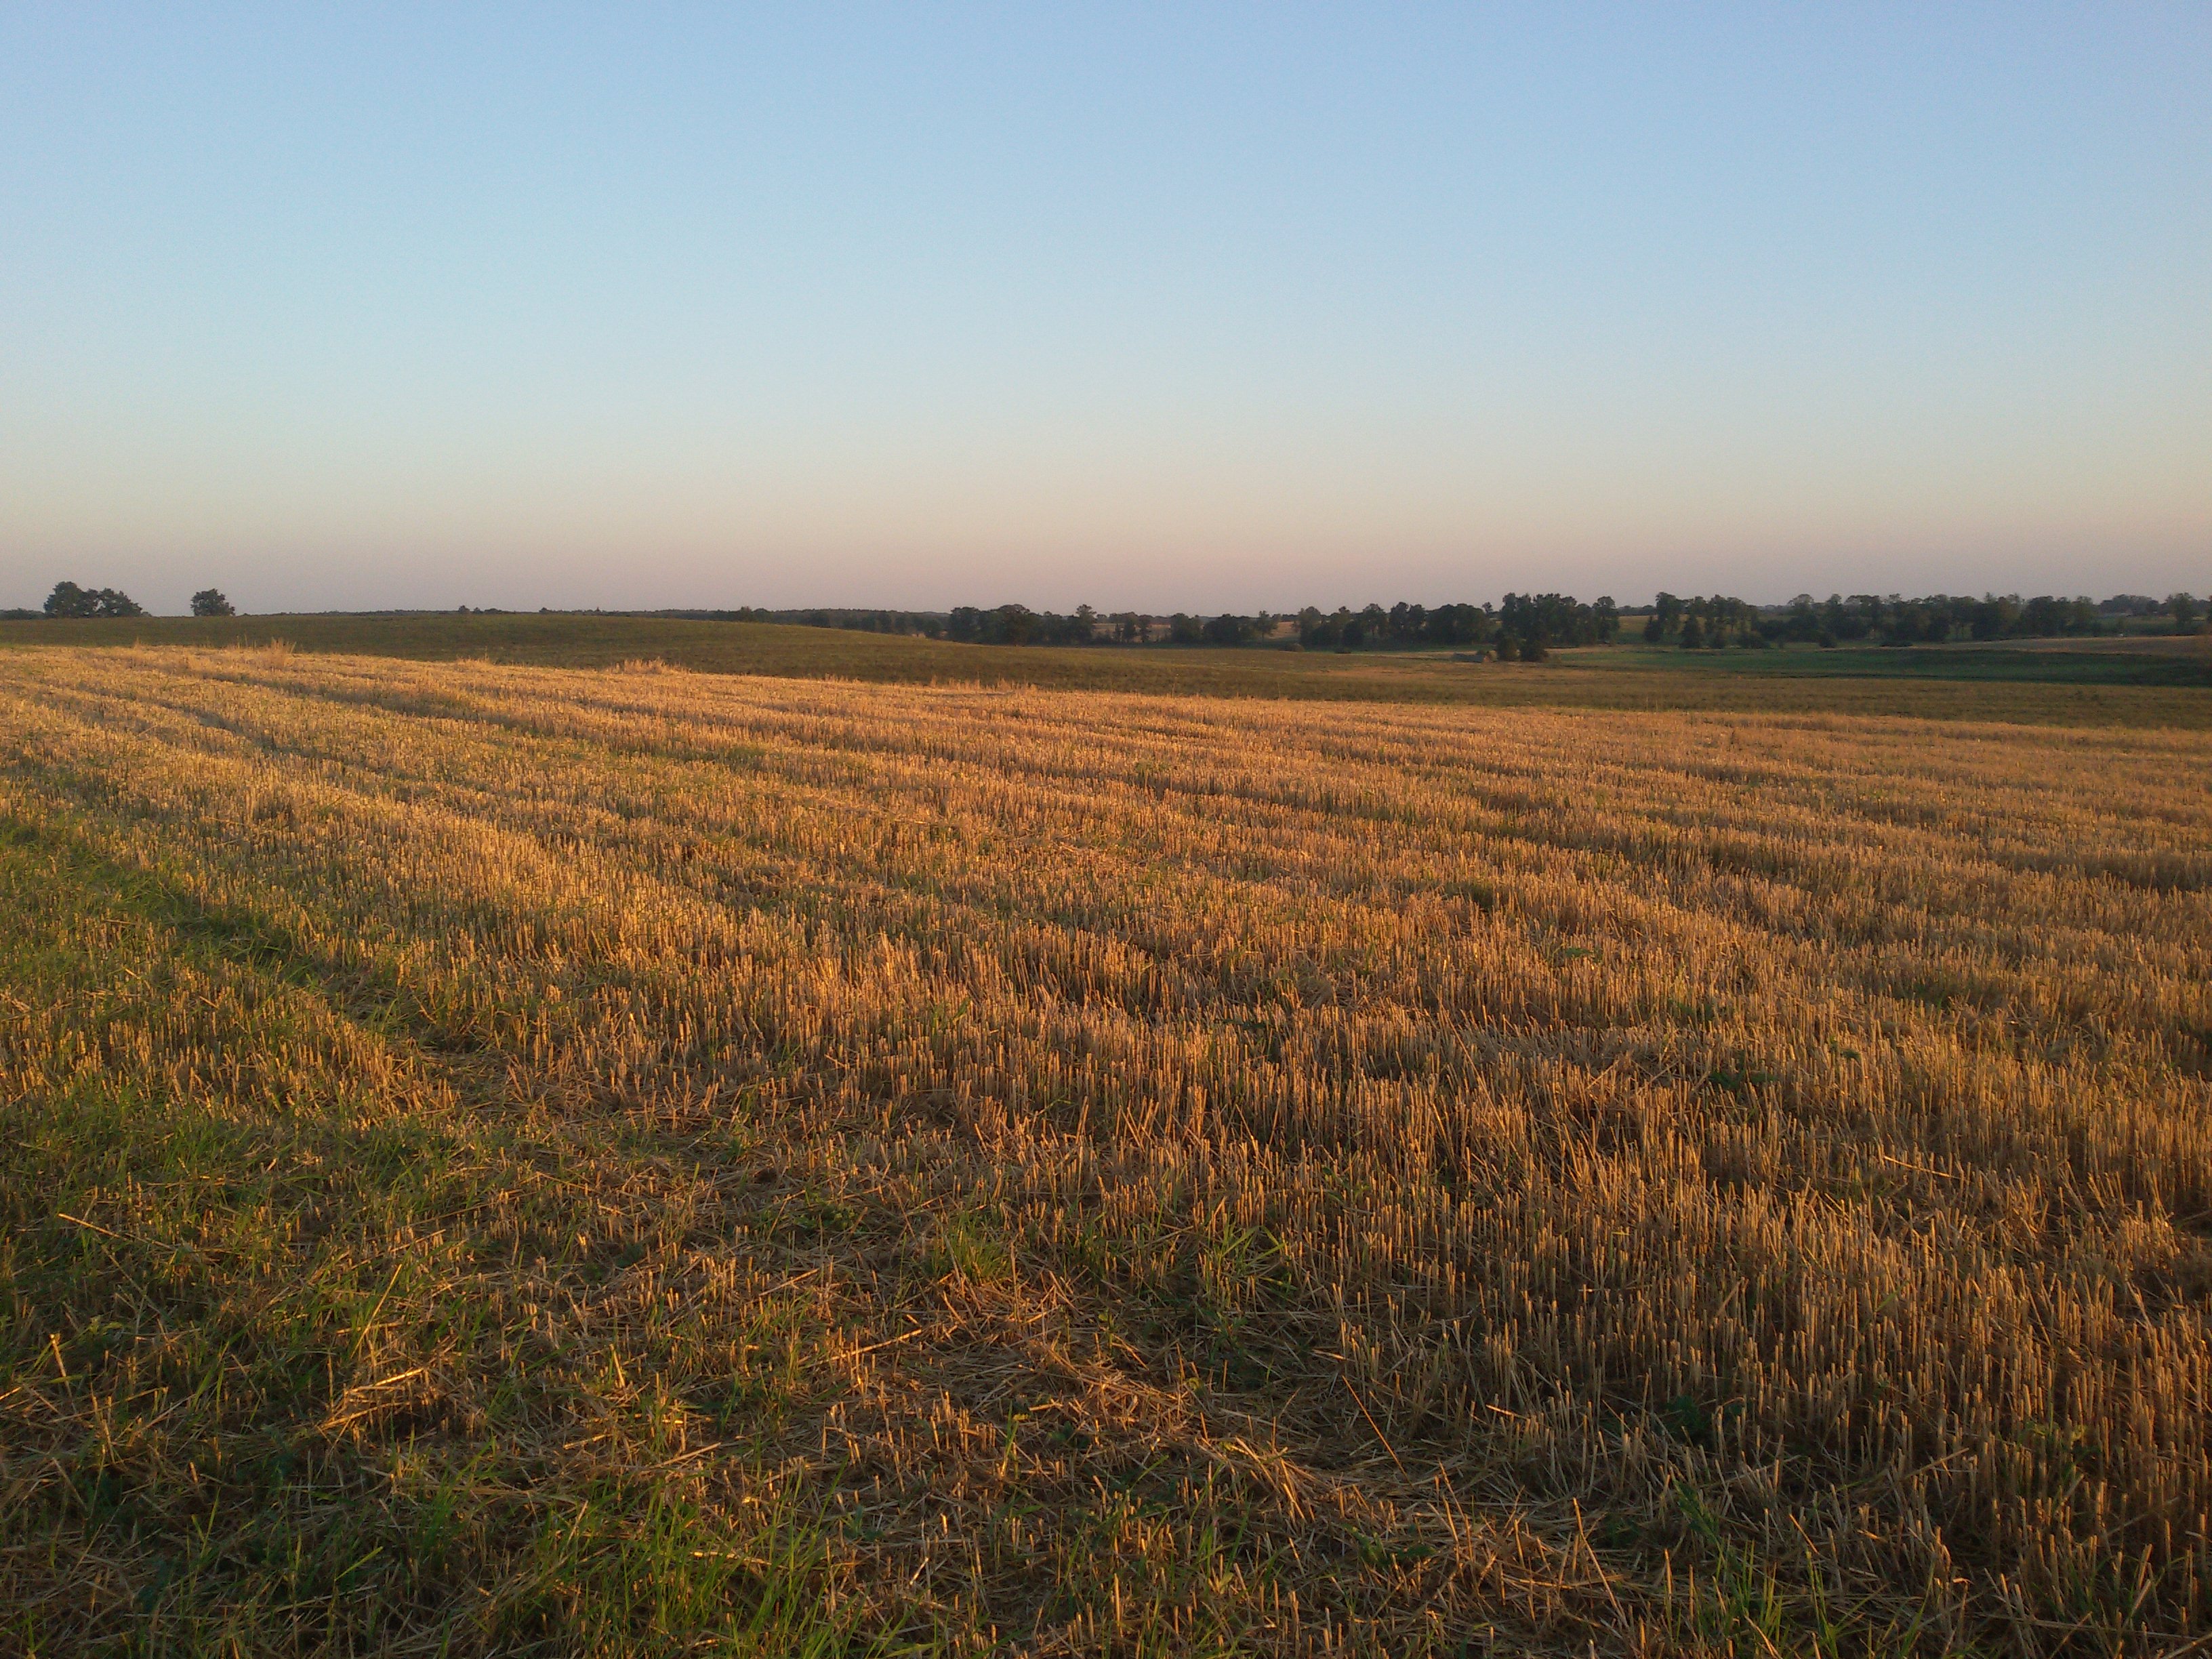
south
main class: Cropland
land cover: Common wheat
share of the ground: > 75 %
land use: Agriculture (excluding fallow land and kitchen gardens)
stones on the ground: < 10 %
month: August
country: PL
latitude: 54.0447
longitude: 21.1782
